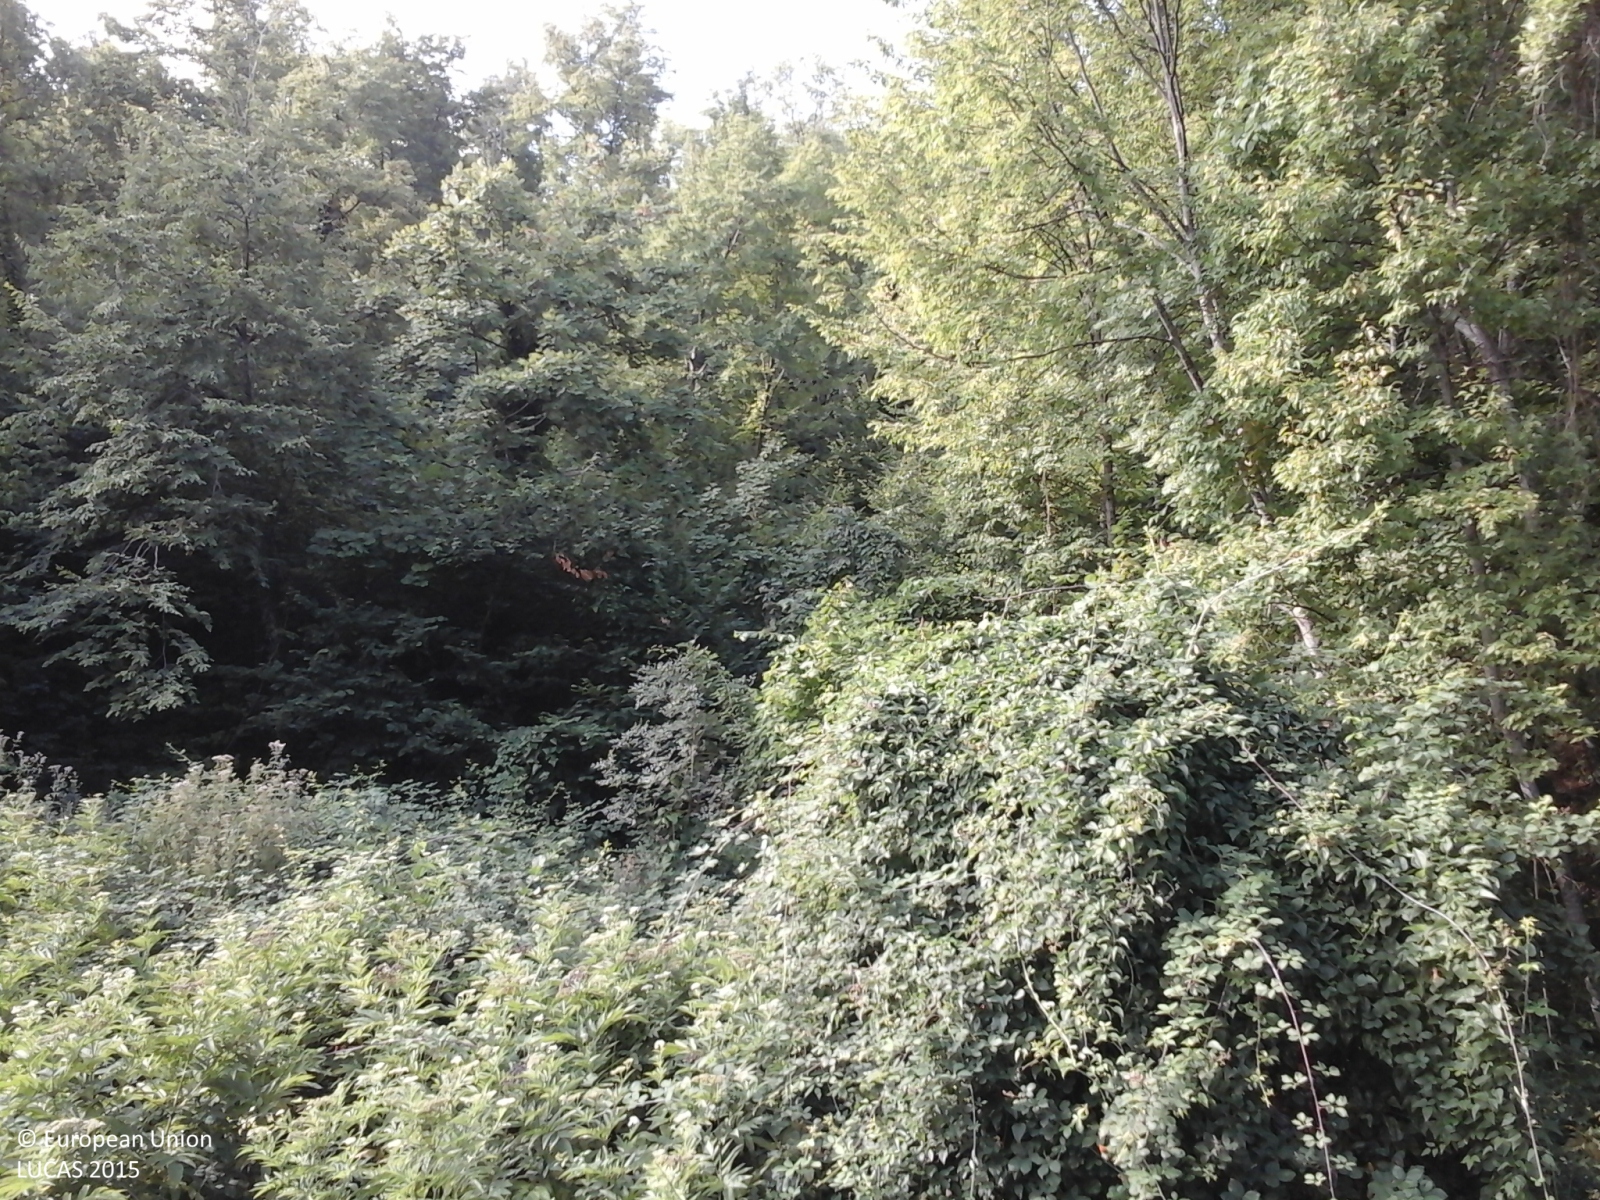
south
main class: Woodland
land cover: Broadleaved woodland
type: thermophilous deciduous forest
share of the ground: > 75 %
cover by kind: broadleaved forest trees 90 %, shrubs 5 %, herbaceous plants 5 %
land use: Forestry
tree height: > 5 m
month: July
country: IT
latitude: 41.8396
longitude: 14.6934
